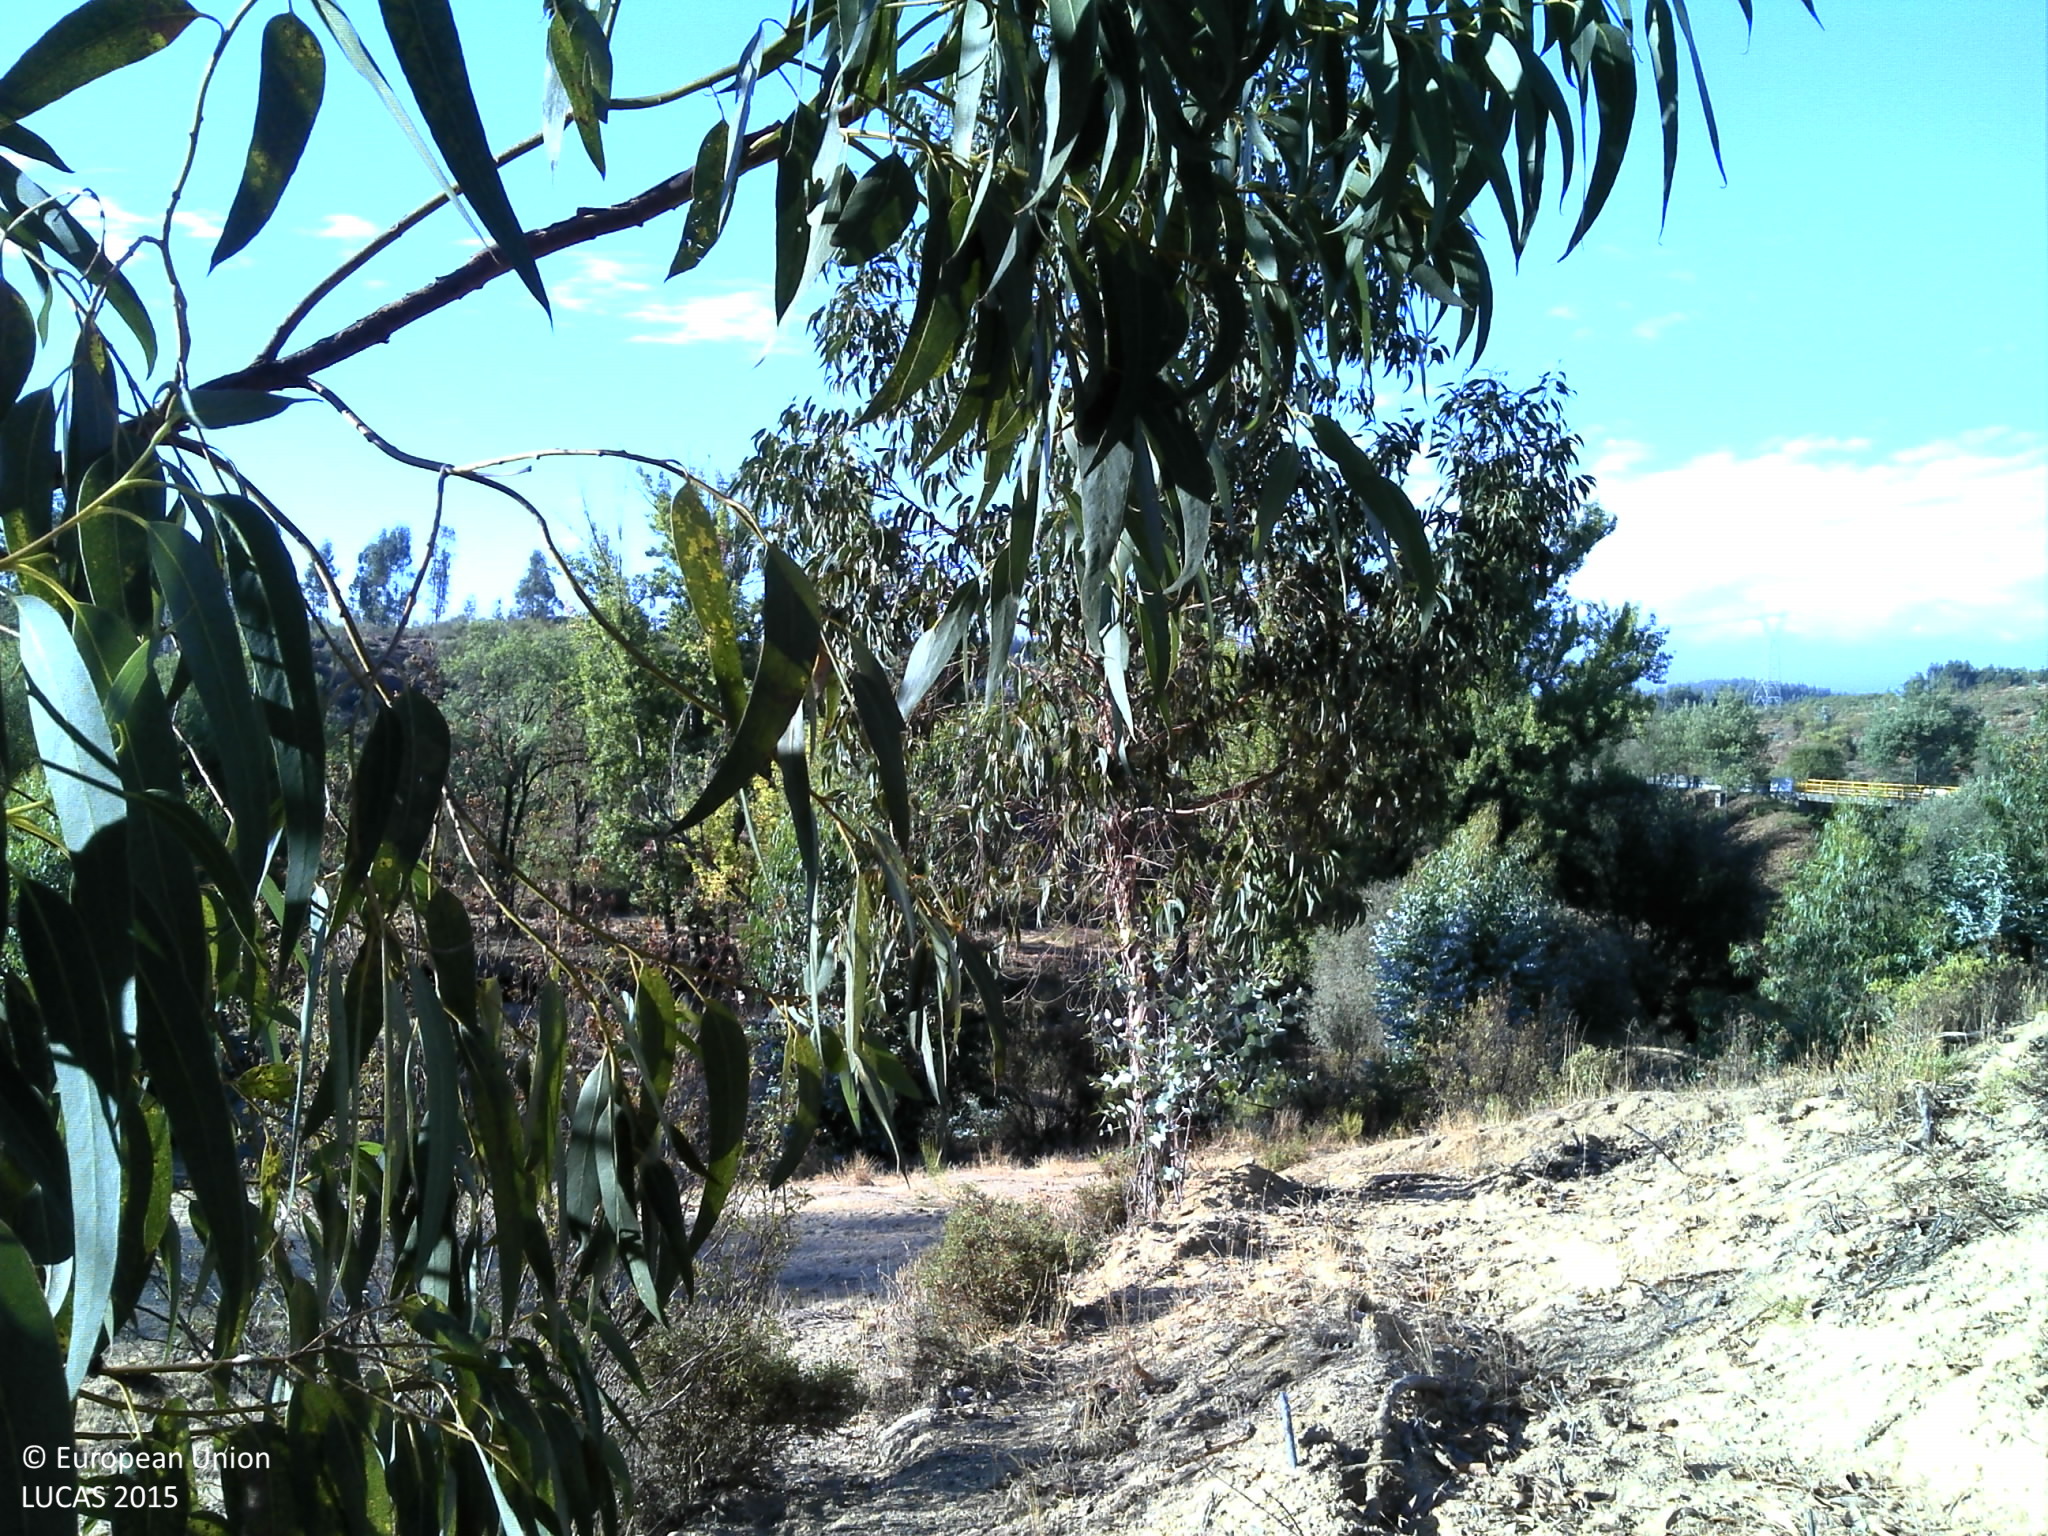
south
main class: Woodland
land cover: Broadleaved woodland
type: broadleaved evergreen forest
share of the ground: 10 - 25 %
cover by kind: unconsolidated bare surface 75 %, broadleaved forest trees 10 %, herbaceous plants 10 %, shrubs 5 %
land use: Forestry
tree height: > 5 m
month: August
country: PT
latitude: 39.5173
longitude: -7.7690
